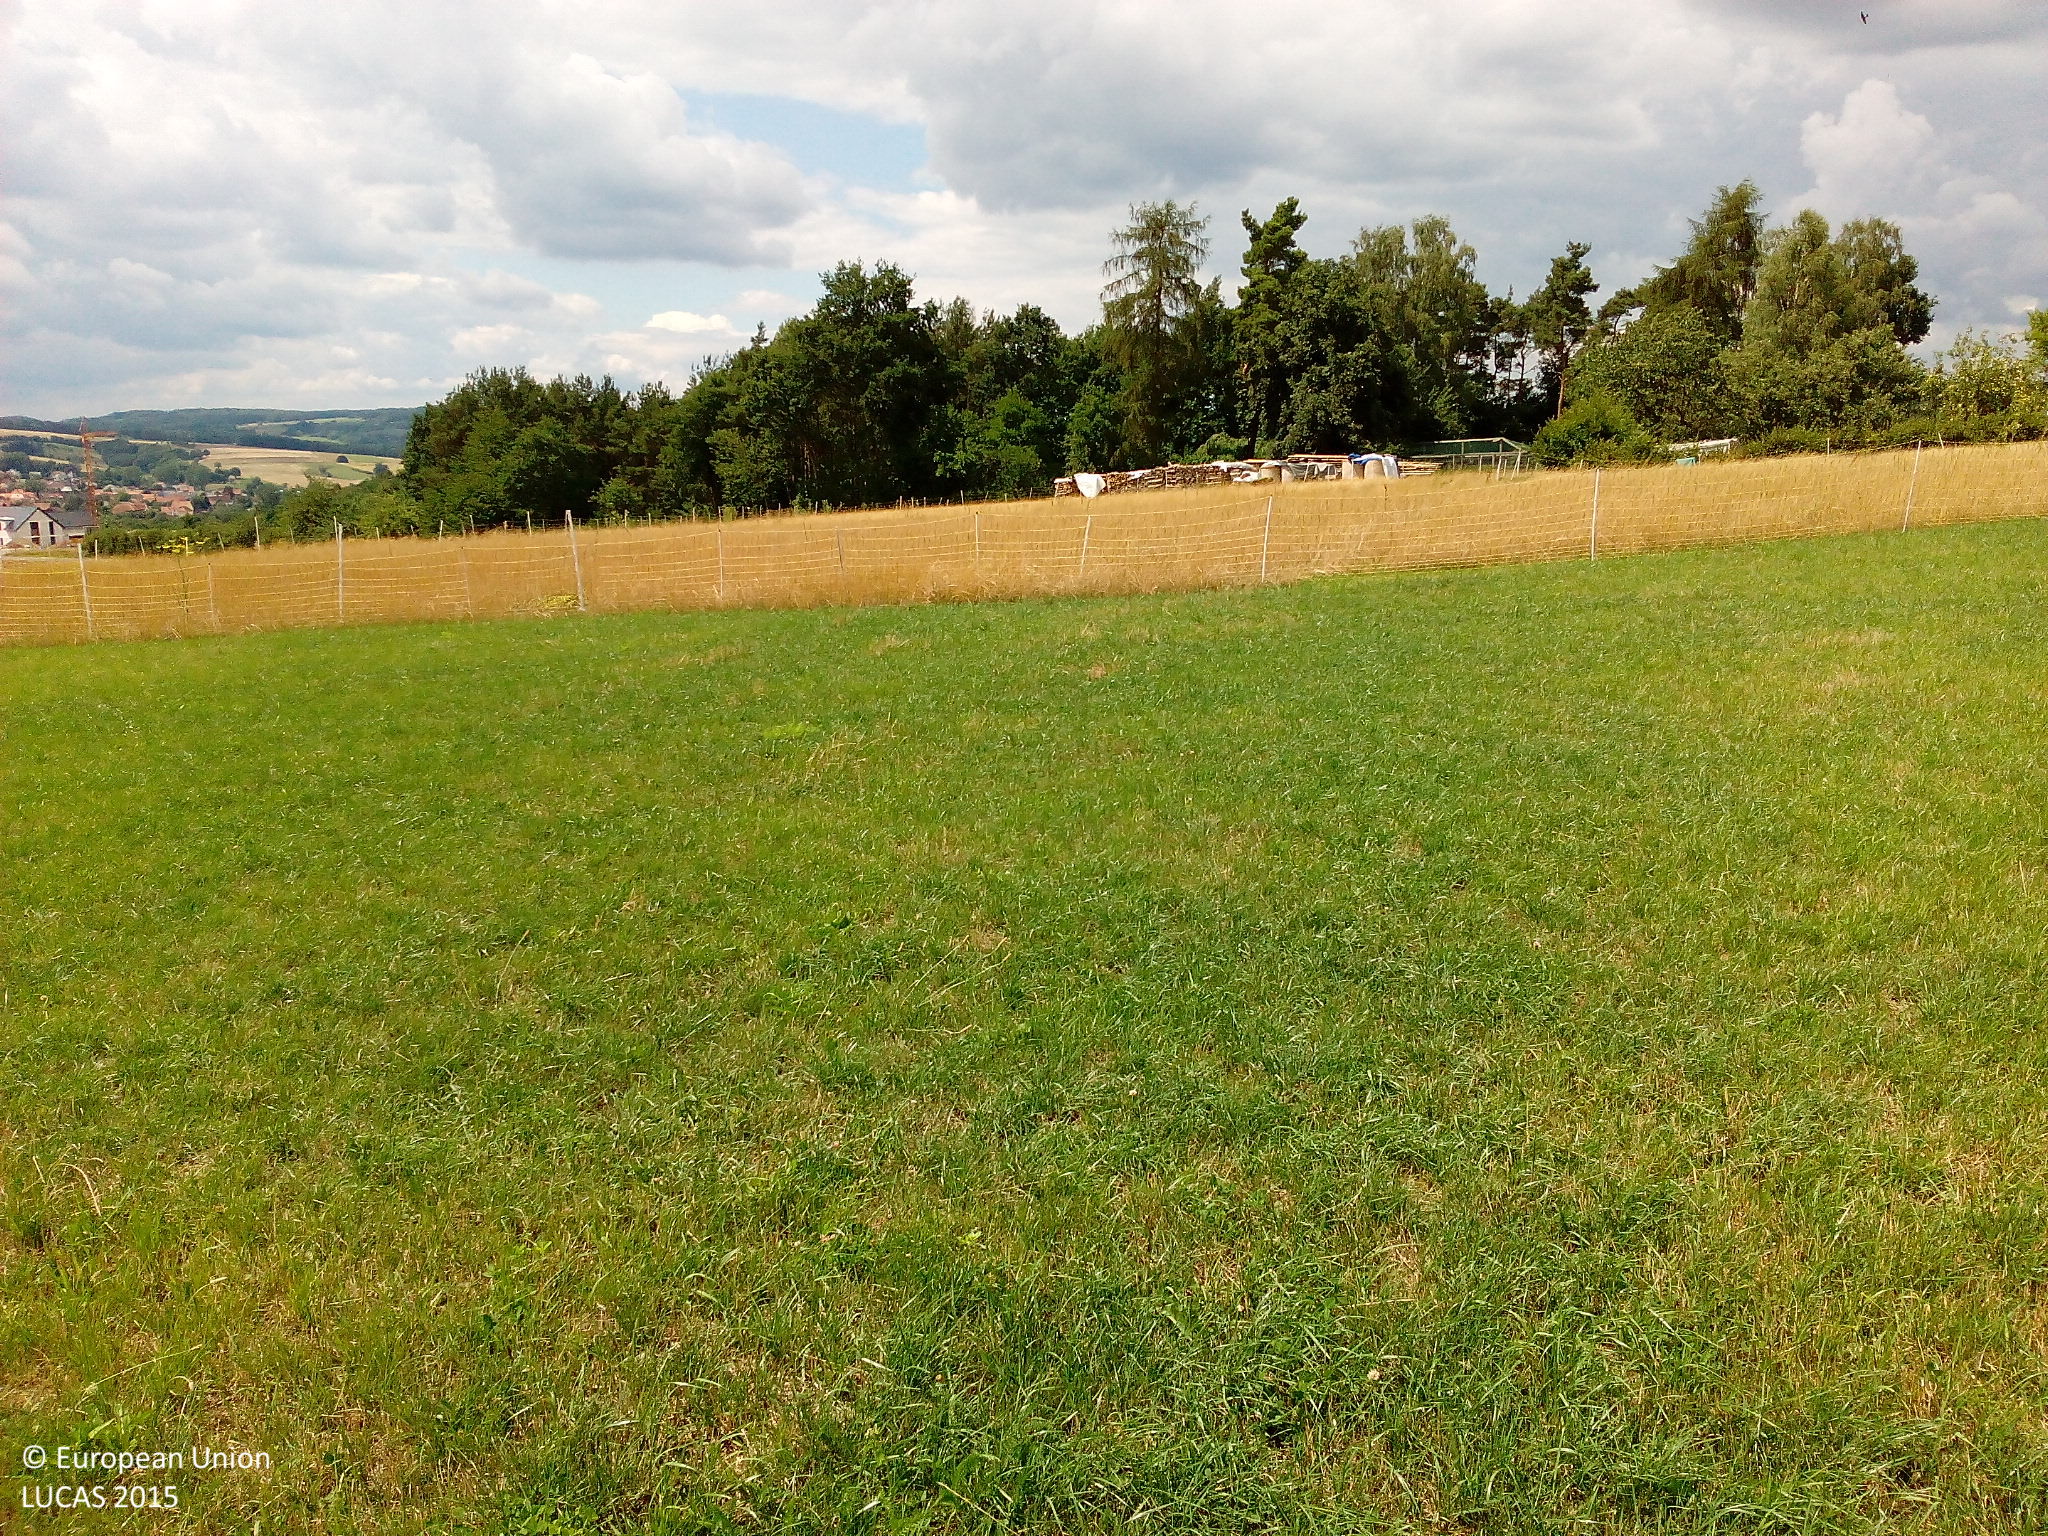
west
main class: Grassland
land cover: Grassland without tree/shrub cover
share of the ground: > 75 %
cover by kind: herbaceous plants 100 %
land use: Agriculture (excluding fallow land and kitchen gardens)
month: July
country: DE
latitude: 50.5791
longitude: 9.5906
